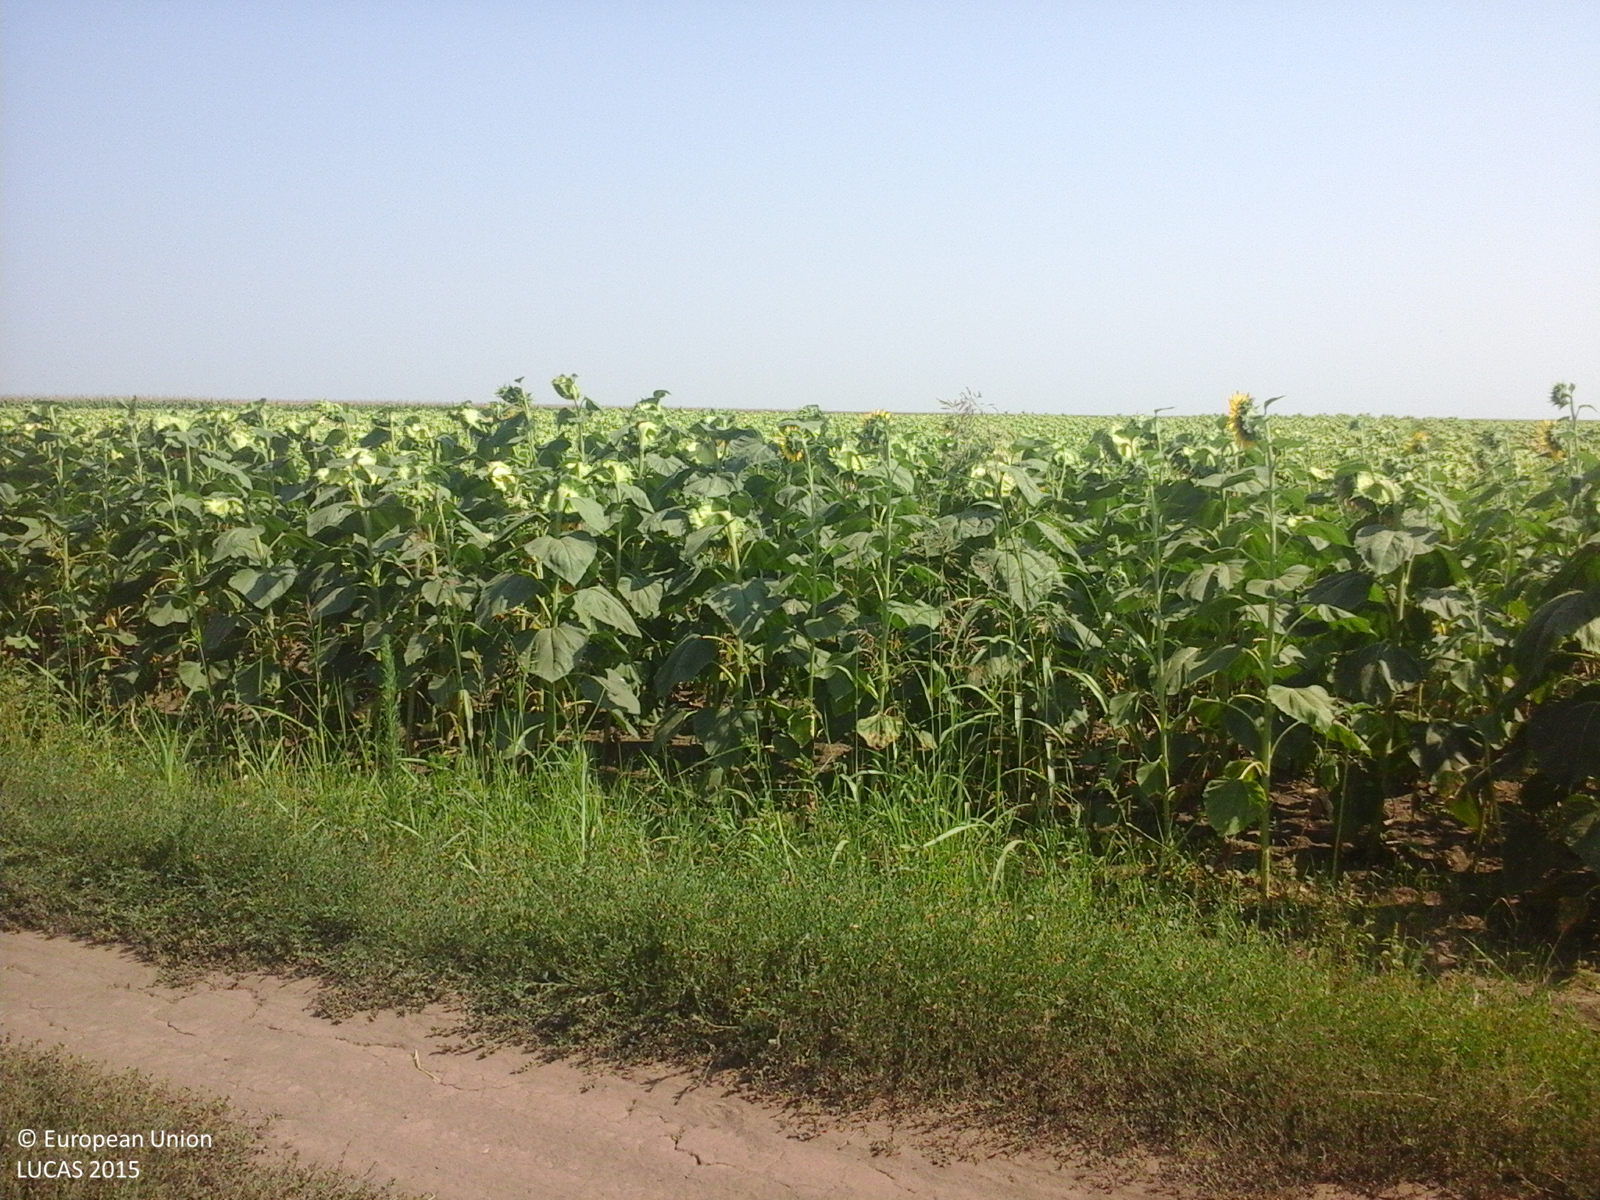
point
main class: Cropland
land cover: Sunflower
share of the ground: > 75 %
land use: Agriculture (excluding fallow land and kitchen gardens)
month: July
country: RO
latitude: 45.6511
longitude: 27.5966
